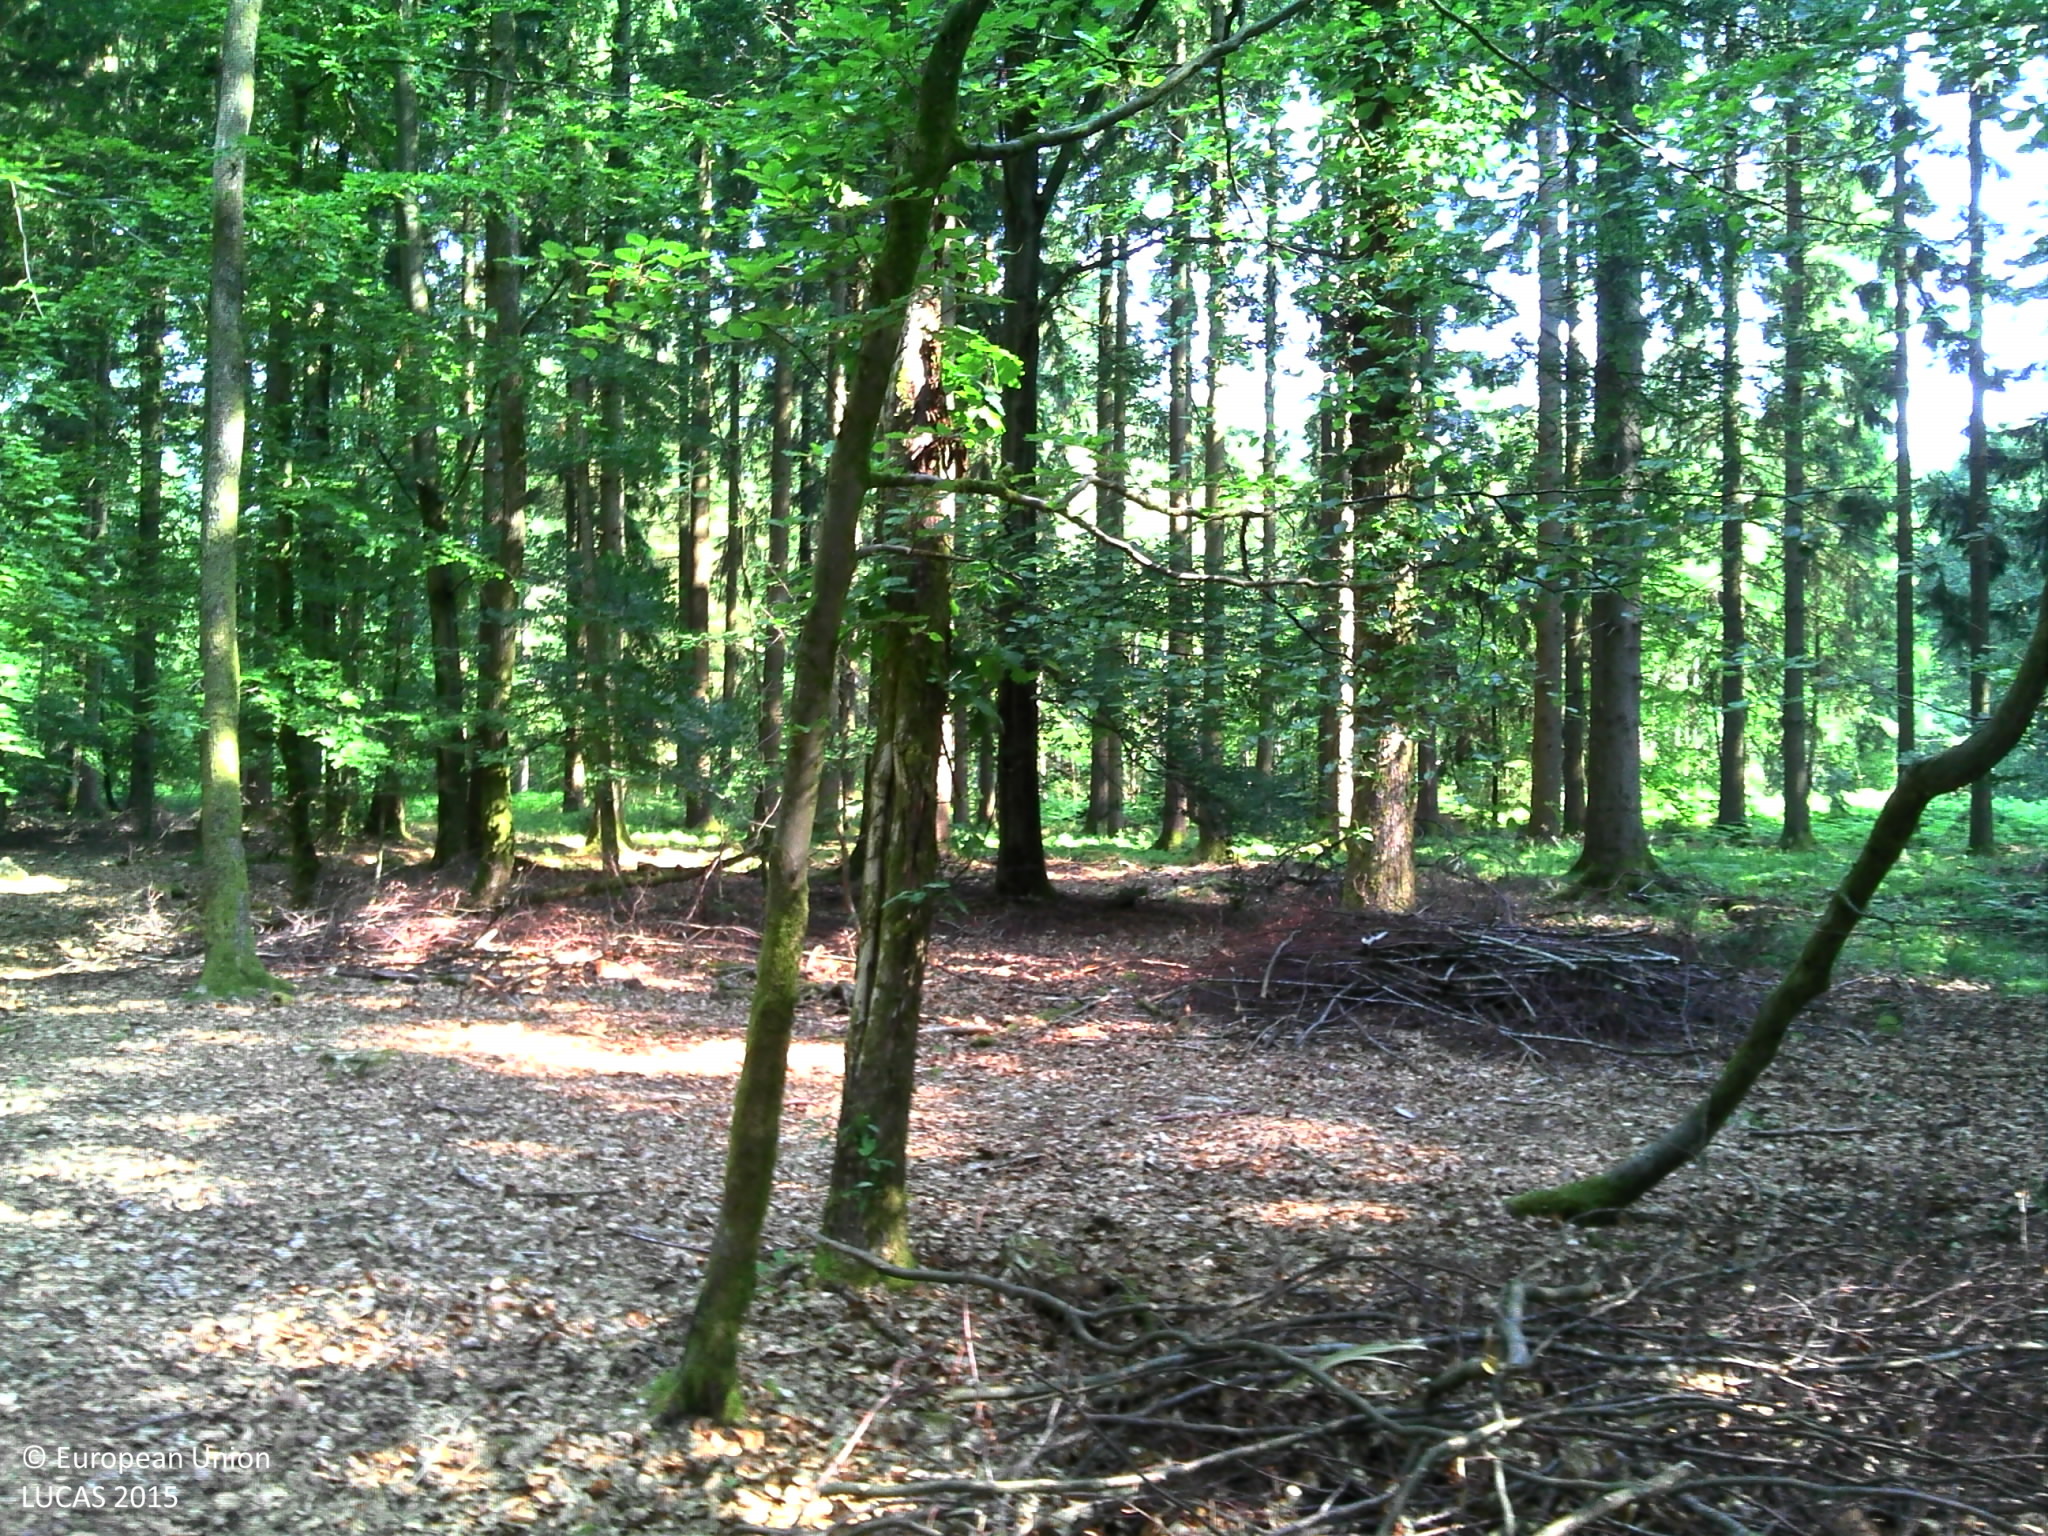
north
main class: Woodland
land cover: Broadleaved woodland
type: acidophilous oak and oak-birch forest
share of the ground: > 75 %
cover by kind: broadleaved forest trees 95 %, unconsolidated bare surface 5 %
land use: Forestry
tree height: > 5 m
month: June
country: BE
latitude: 49.9253
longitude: 4.8849
